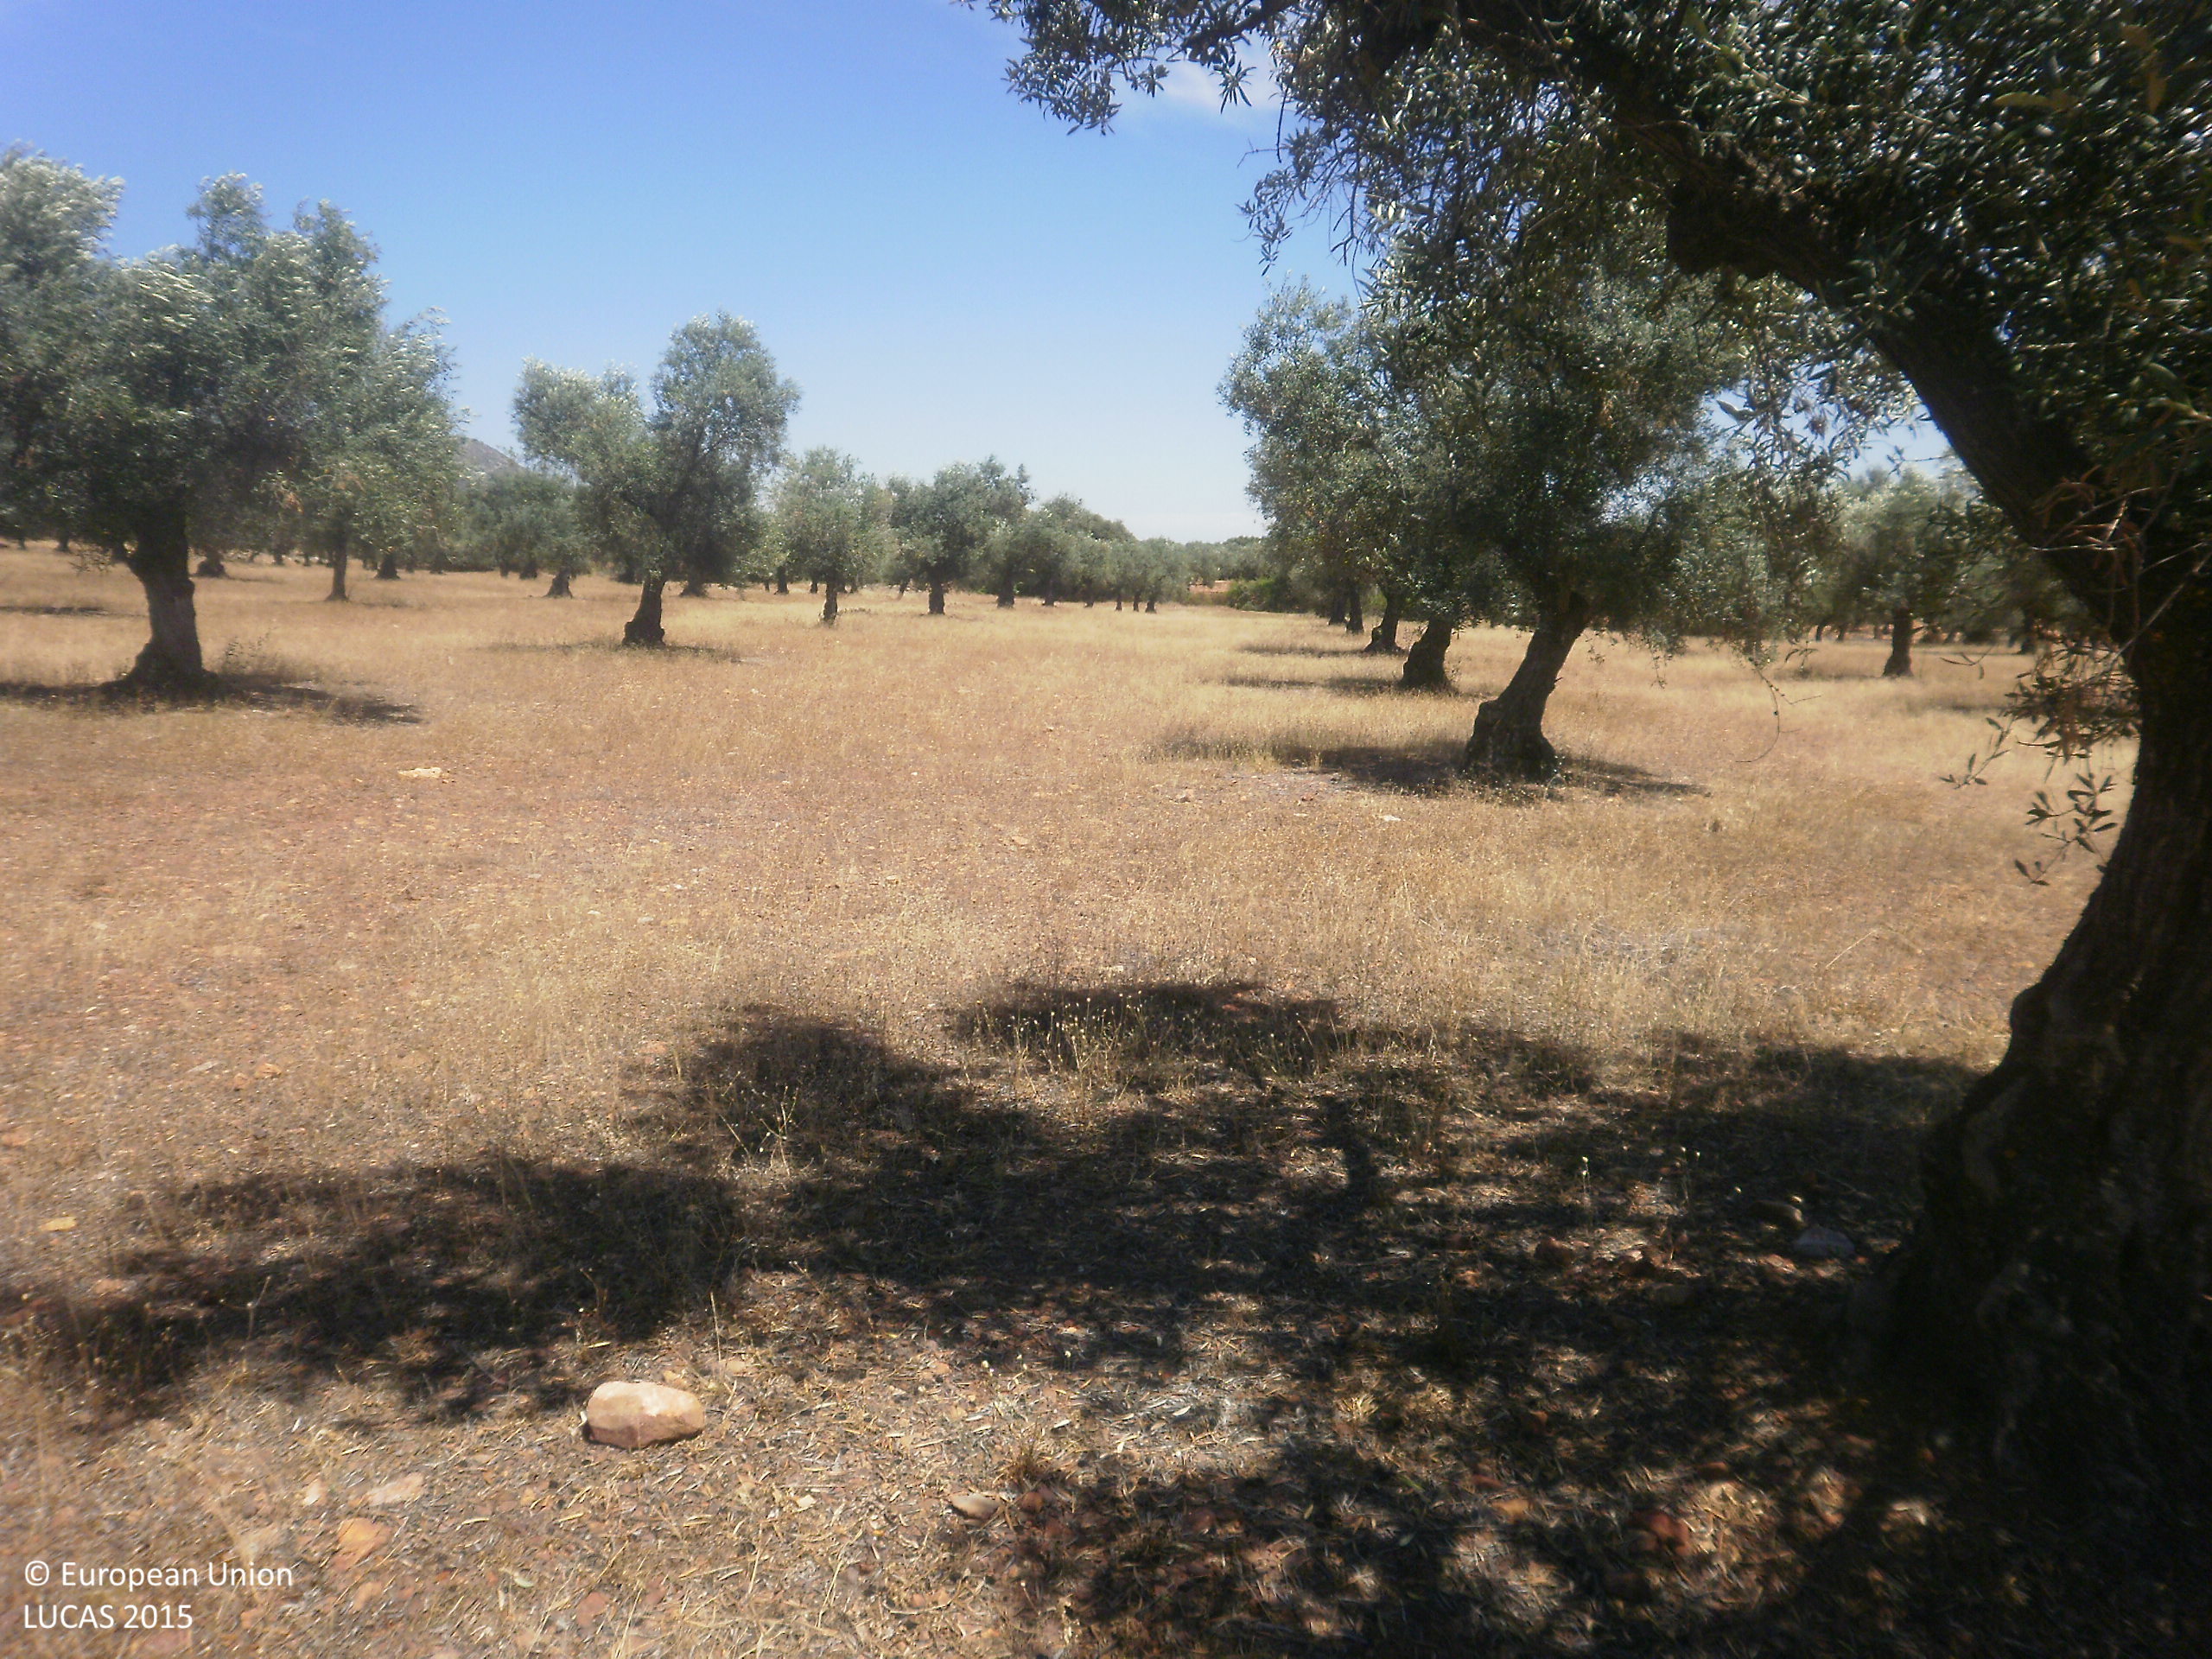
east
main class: Cropland
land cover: Olive groves
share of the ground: 25 - 50 %
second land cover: Grassland without tree/shrub cover
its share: 25 - 50 %
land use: Agriculture (excluding fallow land and kitchen gardens)
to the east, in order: Olive groves; Grassland without tree/shrub cover; Shruby margins; Rivers and streams; Olive groves; Shruby margins; Olive groves
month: June
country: ES
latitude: 38.6711
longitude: -5.4271
